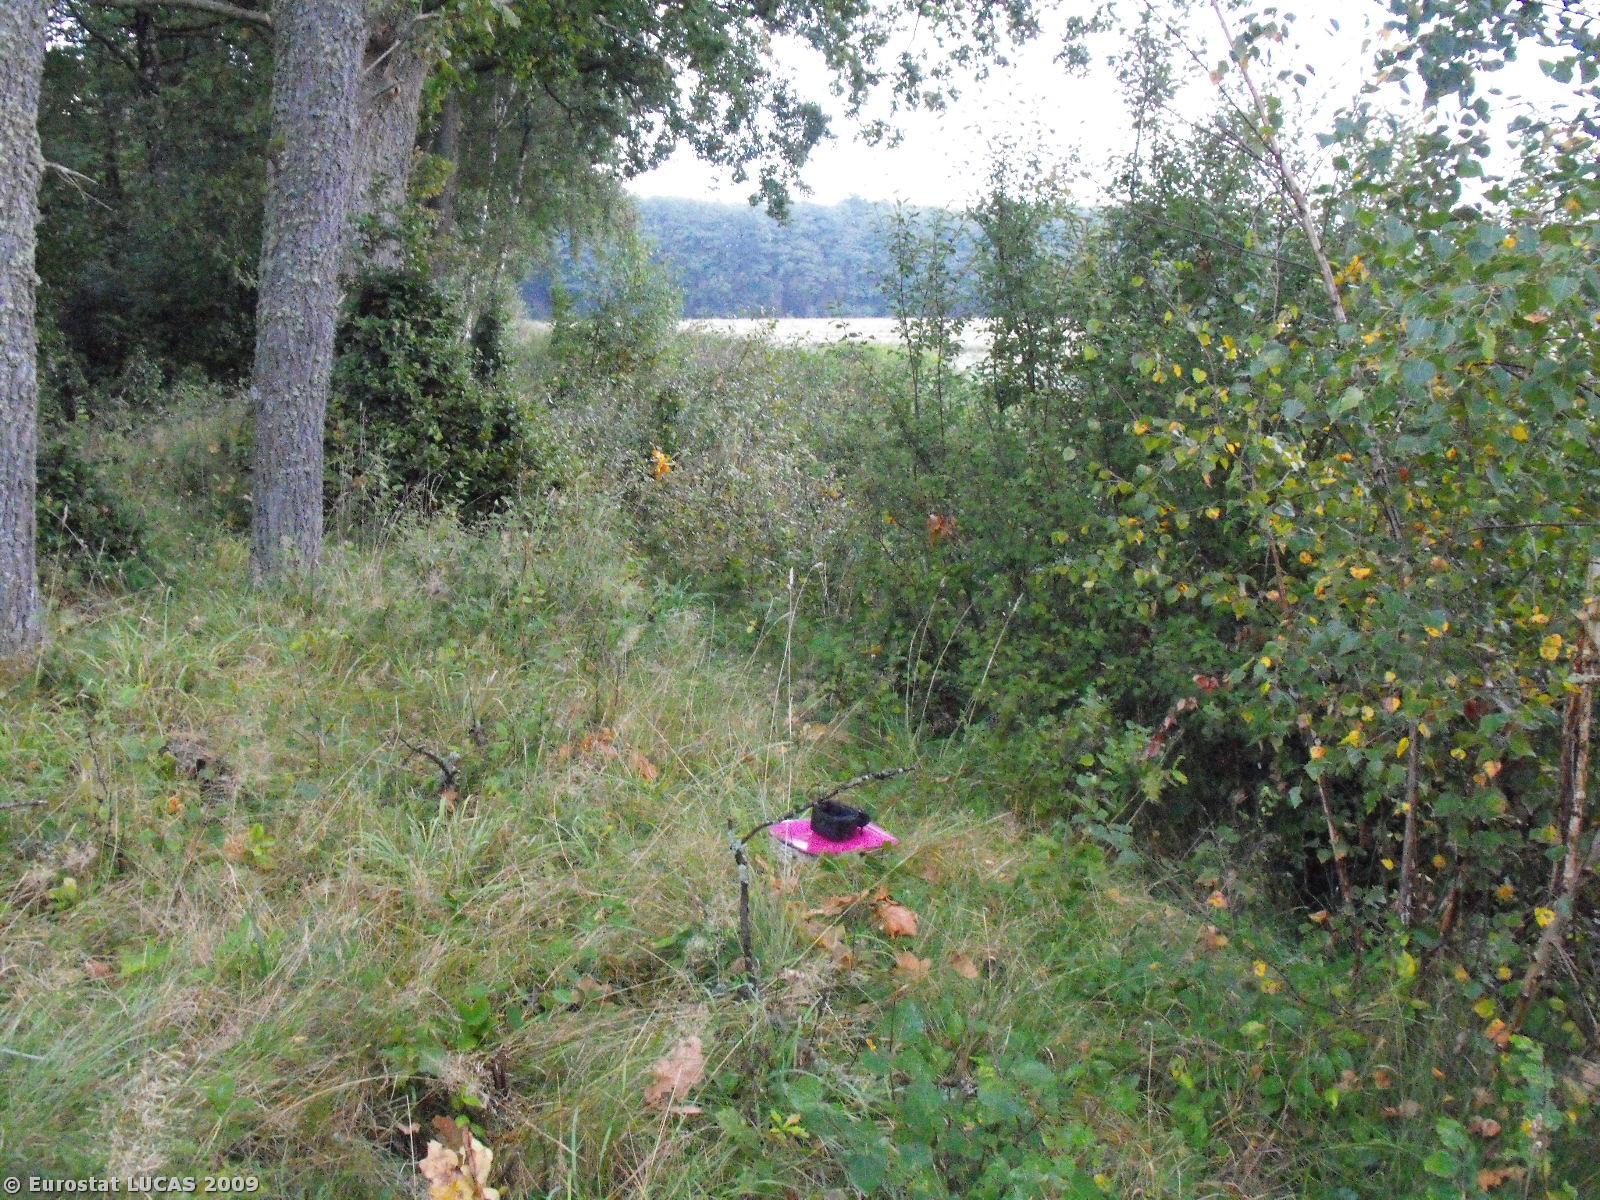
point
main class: Woodland
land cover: Broadleaved woodland
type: hemiboreal forest and nemoral coniferous forest and mixed broadleaved-coniferous forest
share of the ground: > 75 %
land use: Forestry
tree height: > 5 m
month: September
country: PL
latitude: 54.2976
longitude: 16.7216
